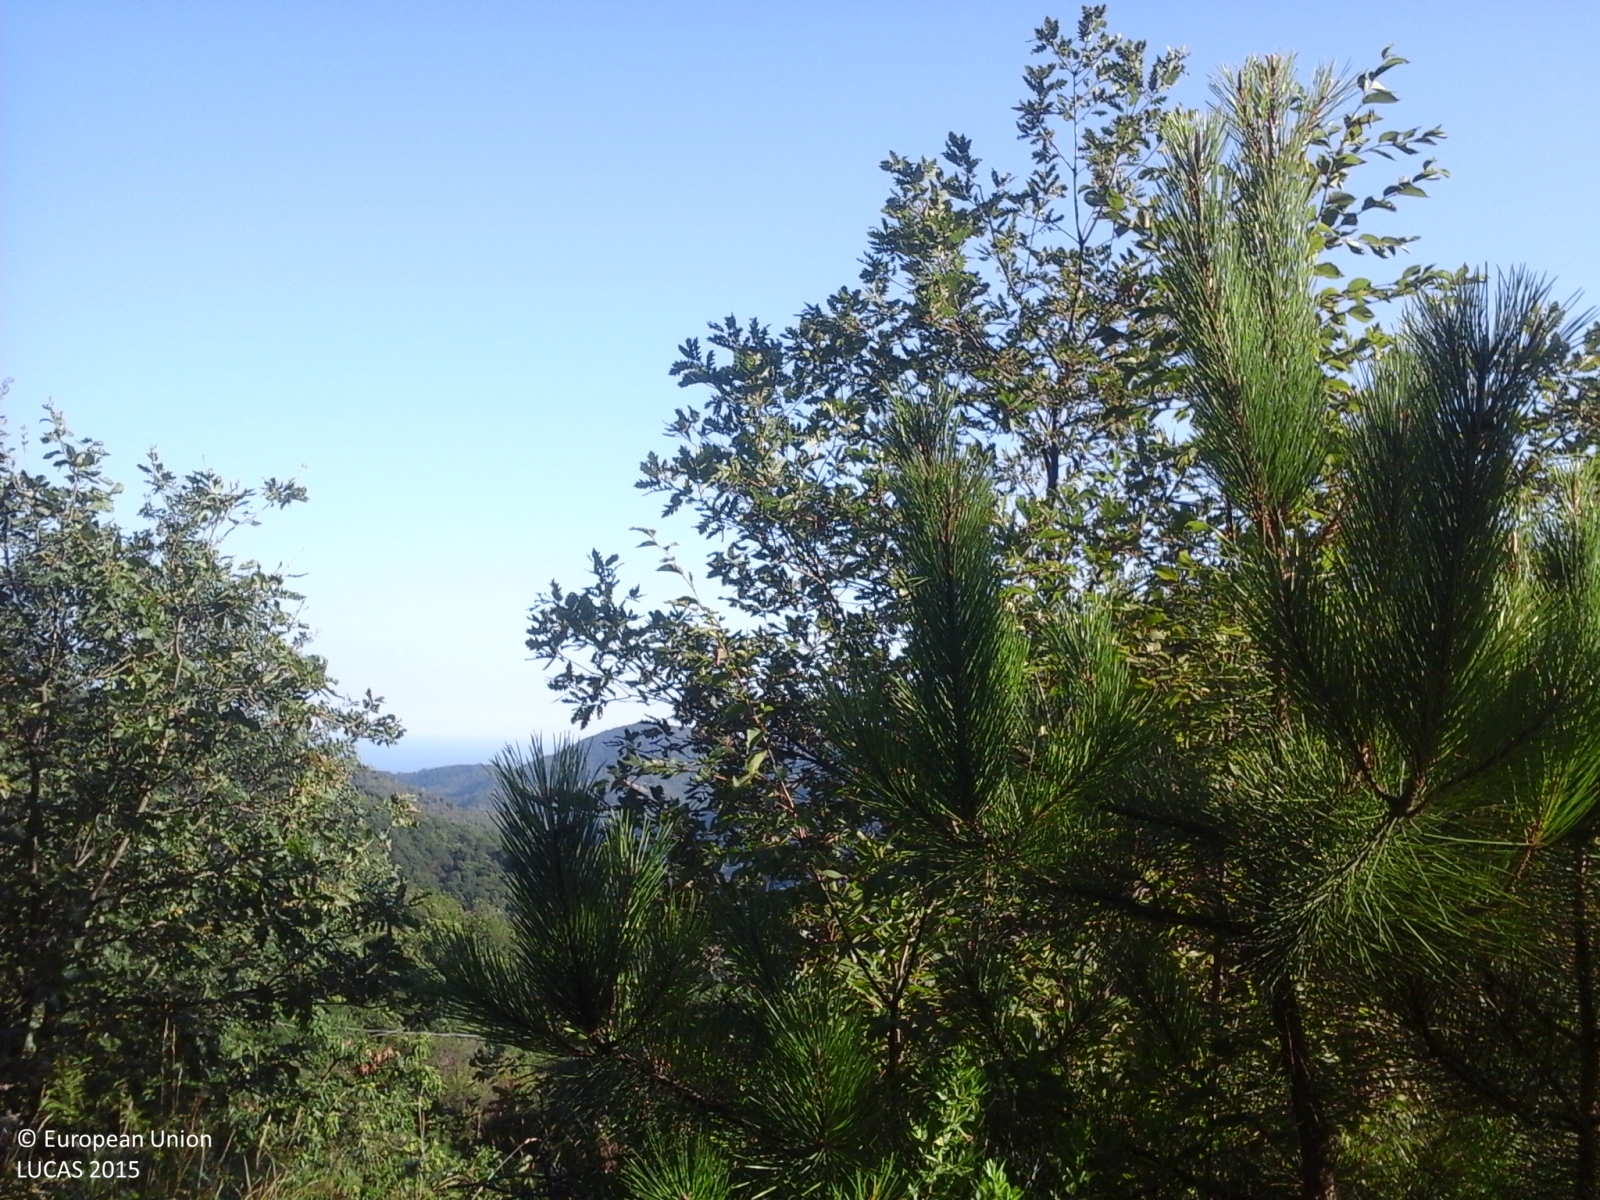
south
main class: Woodland
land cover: Broadleaved woodland
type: thermophilous deciduous forest
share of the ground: > 75 %
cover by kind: broadleaved forest trees 80 %, shrubs 10 %, coniferous forest trees 5 %, herbaceous plants 5 %
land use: Semi-natural and natural areas not in use
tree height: > 5 m
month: August
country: IT
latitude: 44.4688
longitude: 8.7081
